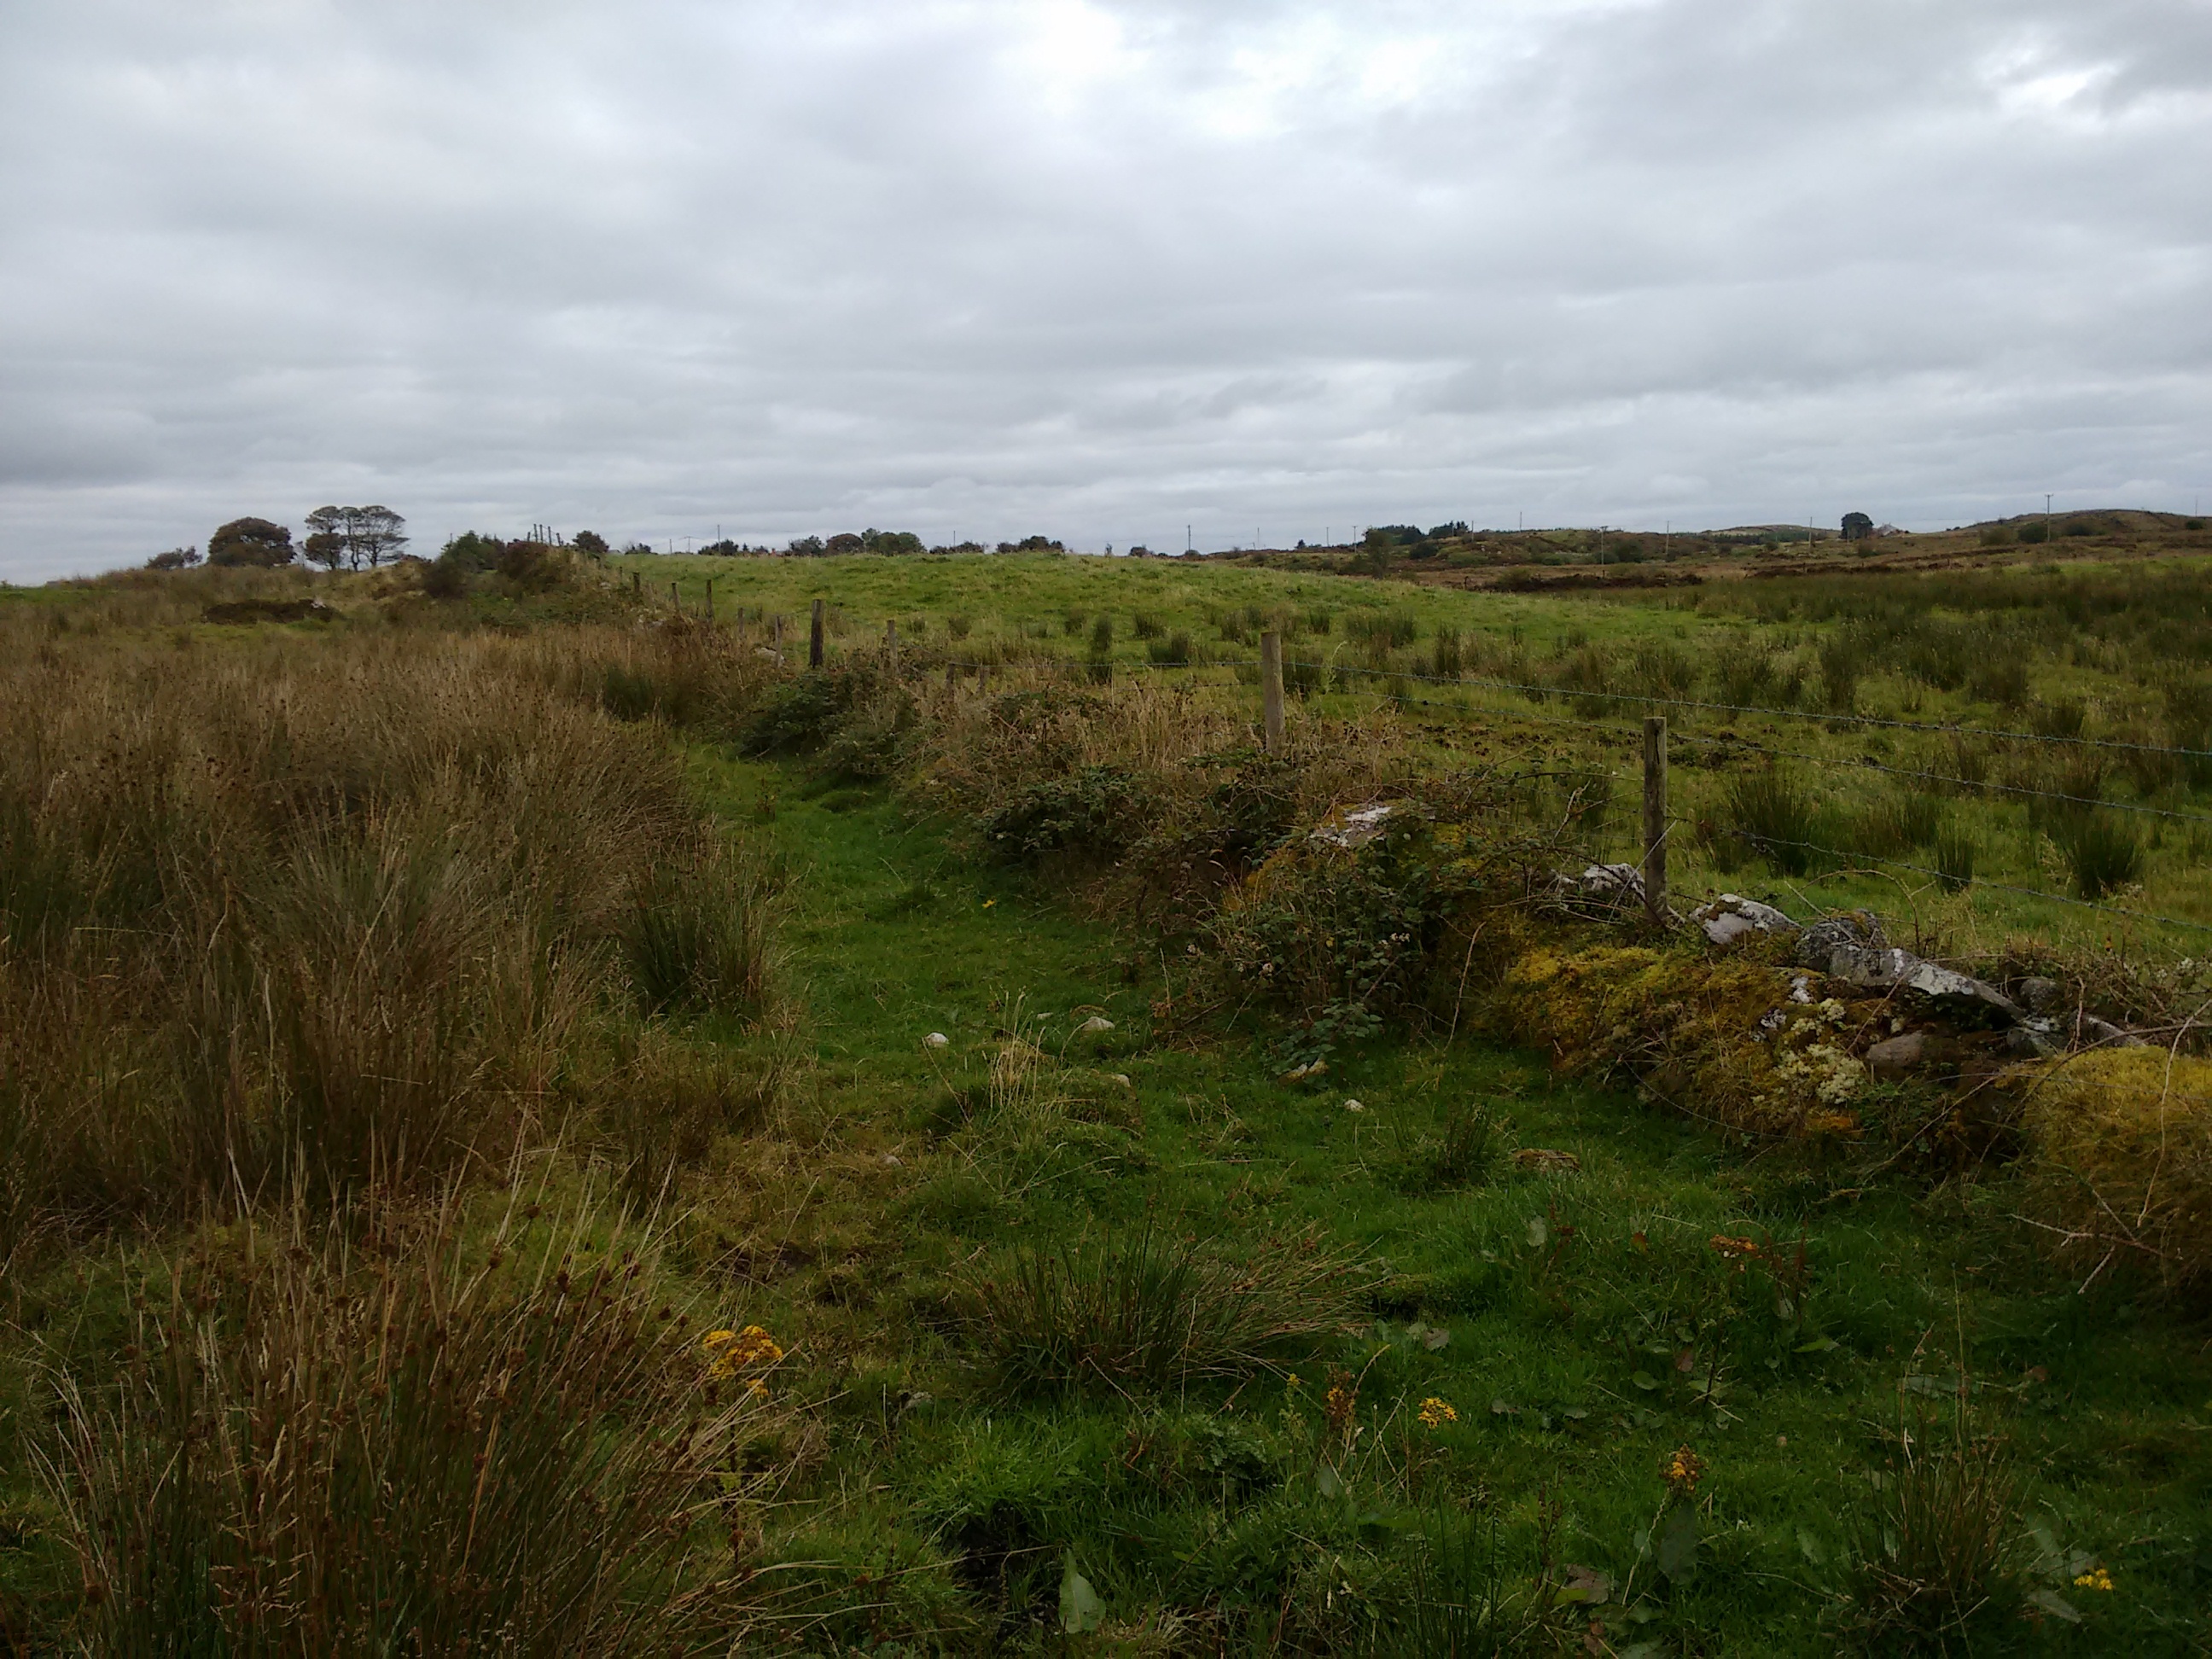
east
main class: Grassland
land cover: Grassland without tree/shrub cover
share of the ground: > 75 %
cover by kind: herbaceous plants 100 %
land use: Agriculture (excluding fallow land and kitchen gardens)
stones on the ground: < 10 %
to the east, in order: Grassland without tree/shrub cover; Dry stone walls; Fences; Grassland without tree/shrub cover; Ditches and canals; Artificial constructions; Fences; Peatbogs; Ditches and canals; Peatbogs; Ditches and canals; Dry stone walls; Fences; Peatbogs
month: September
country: IE
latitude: 53.8997
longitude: -8.8492
